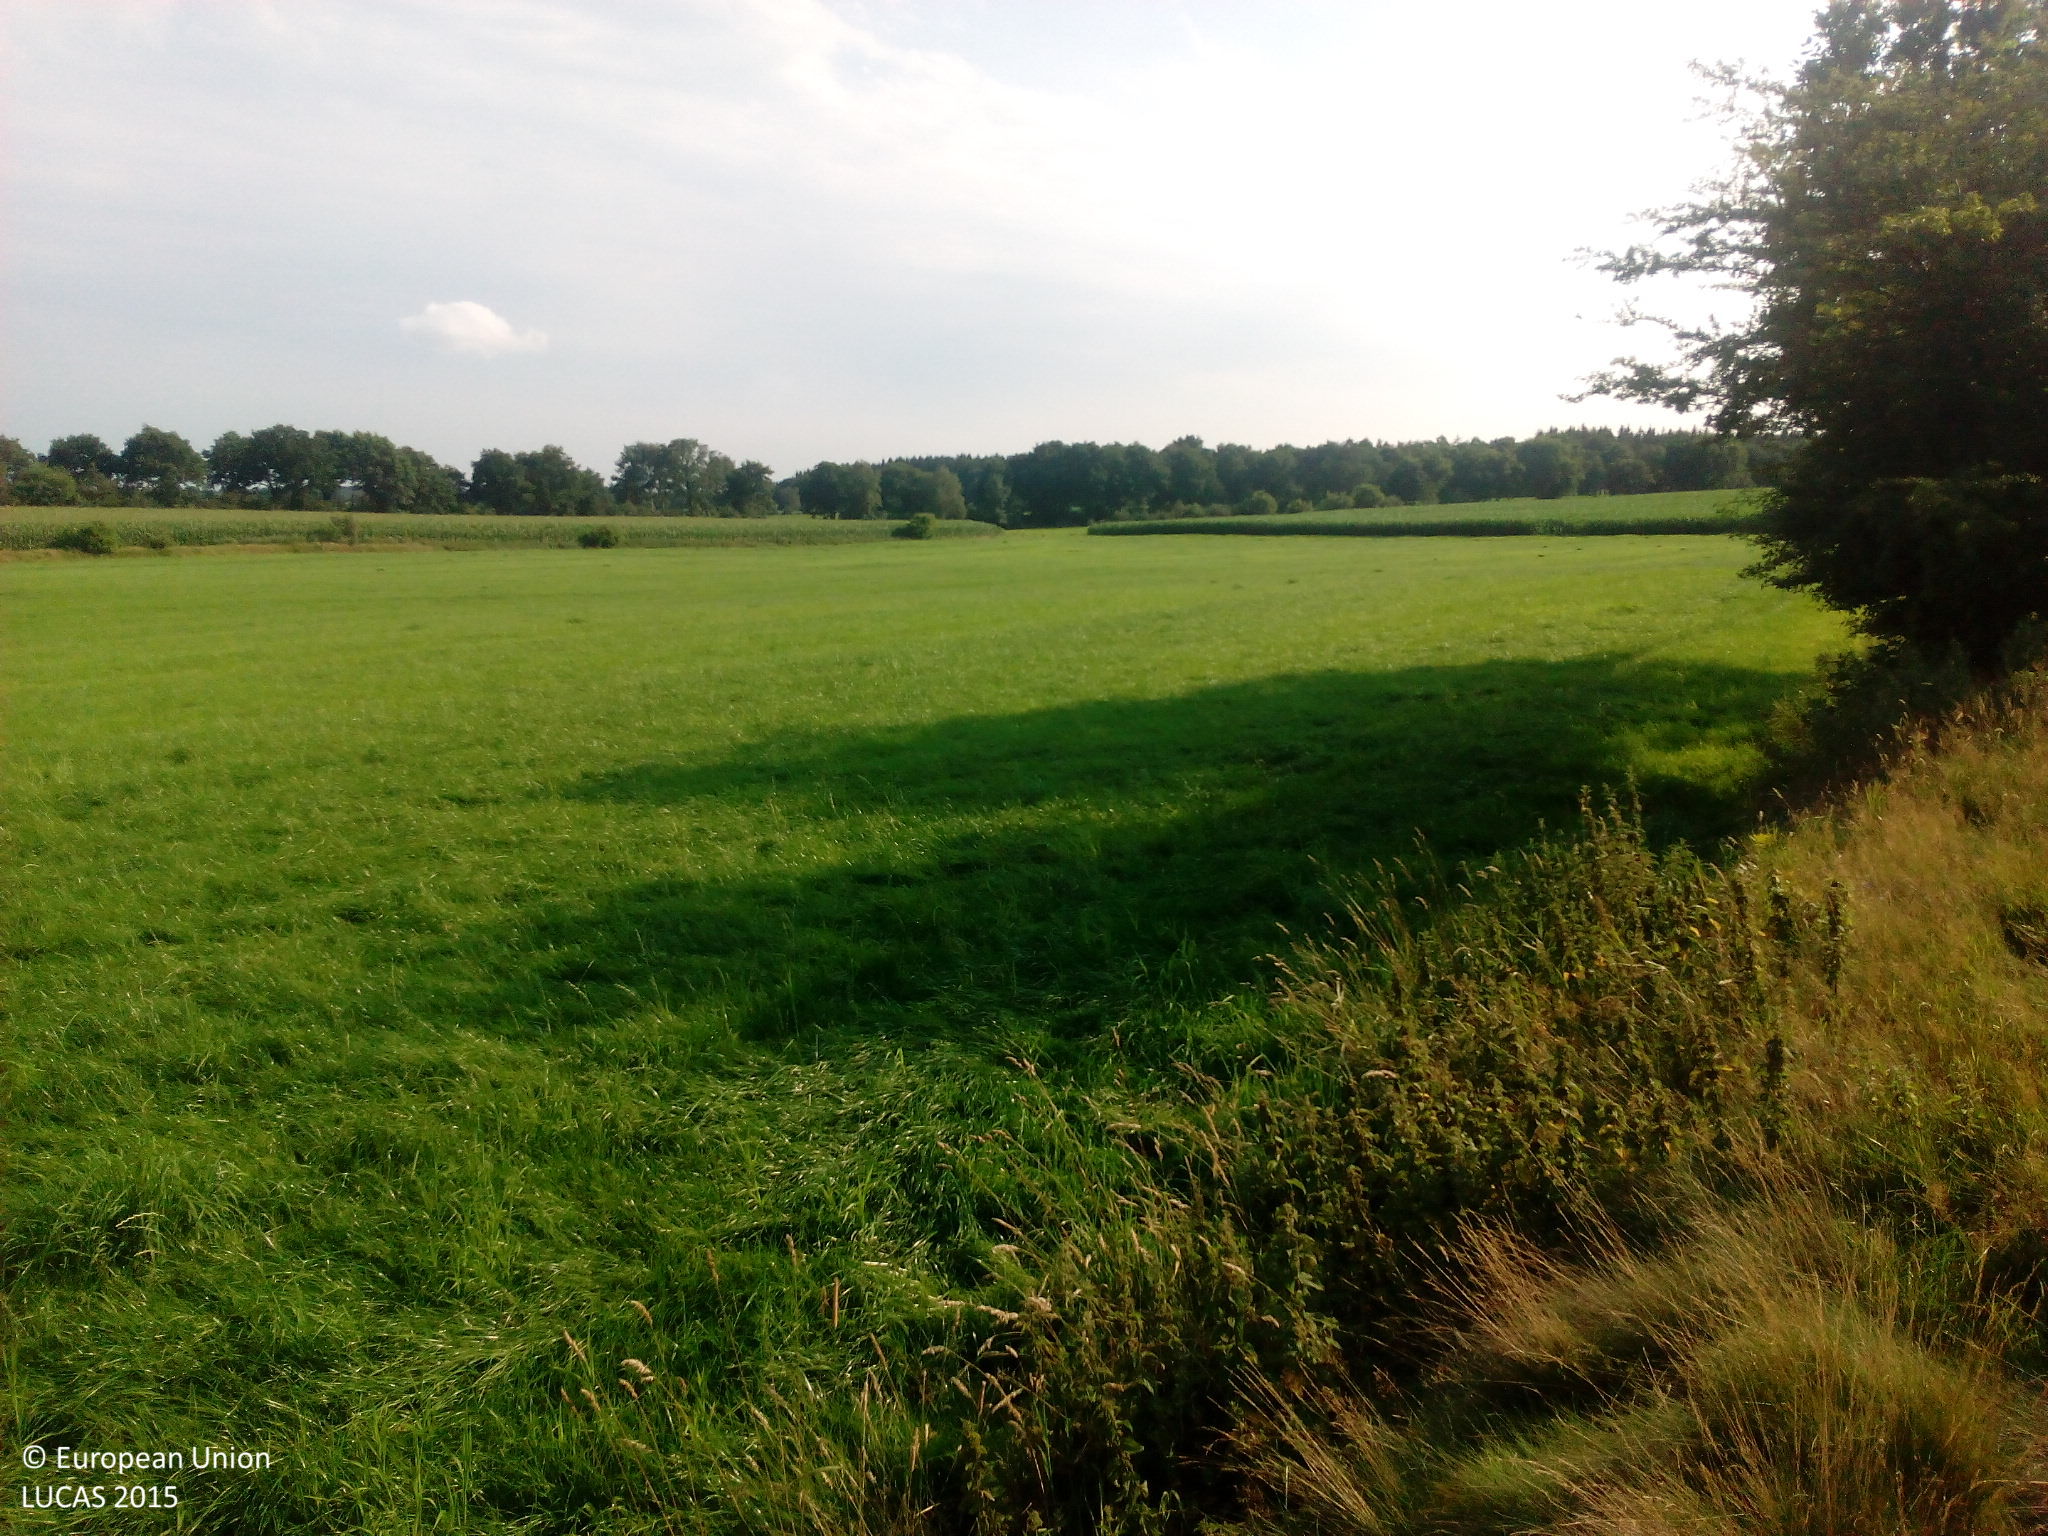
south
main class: Cropland
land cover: Maize
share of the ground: > 75 %
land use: Agriculture (excluding fallow land and kitchen gardens)
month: August
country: DE
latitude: 53.9923
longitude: 9.1921
